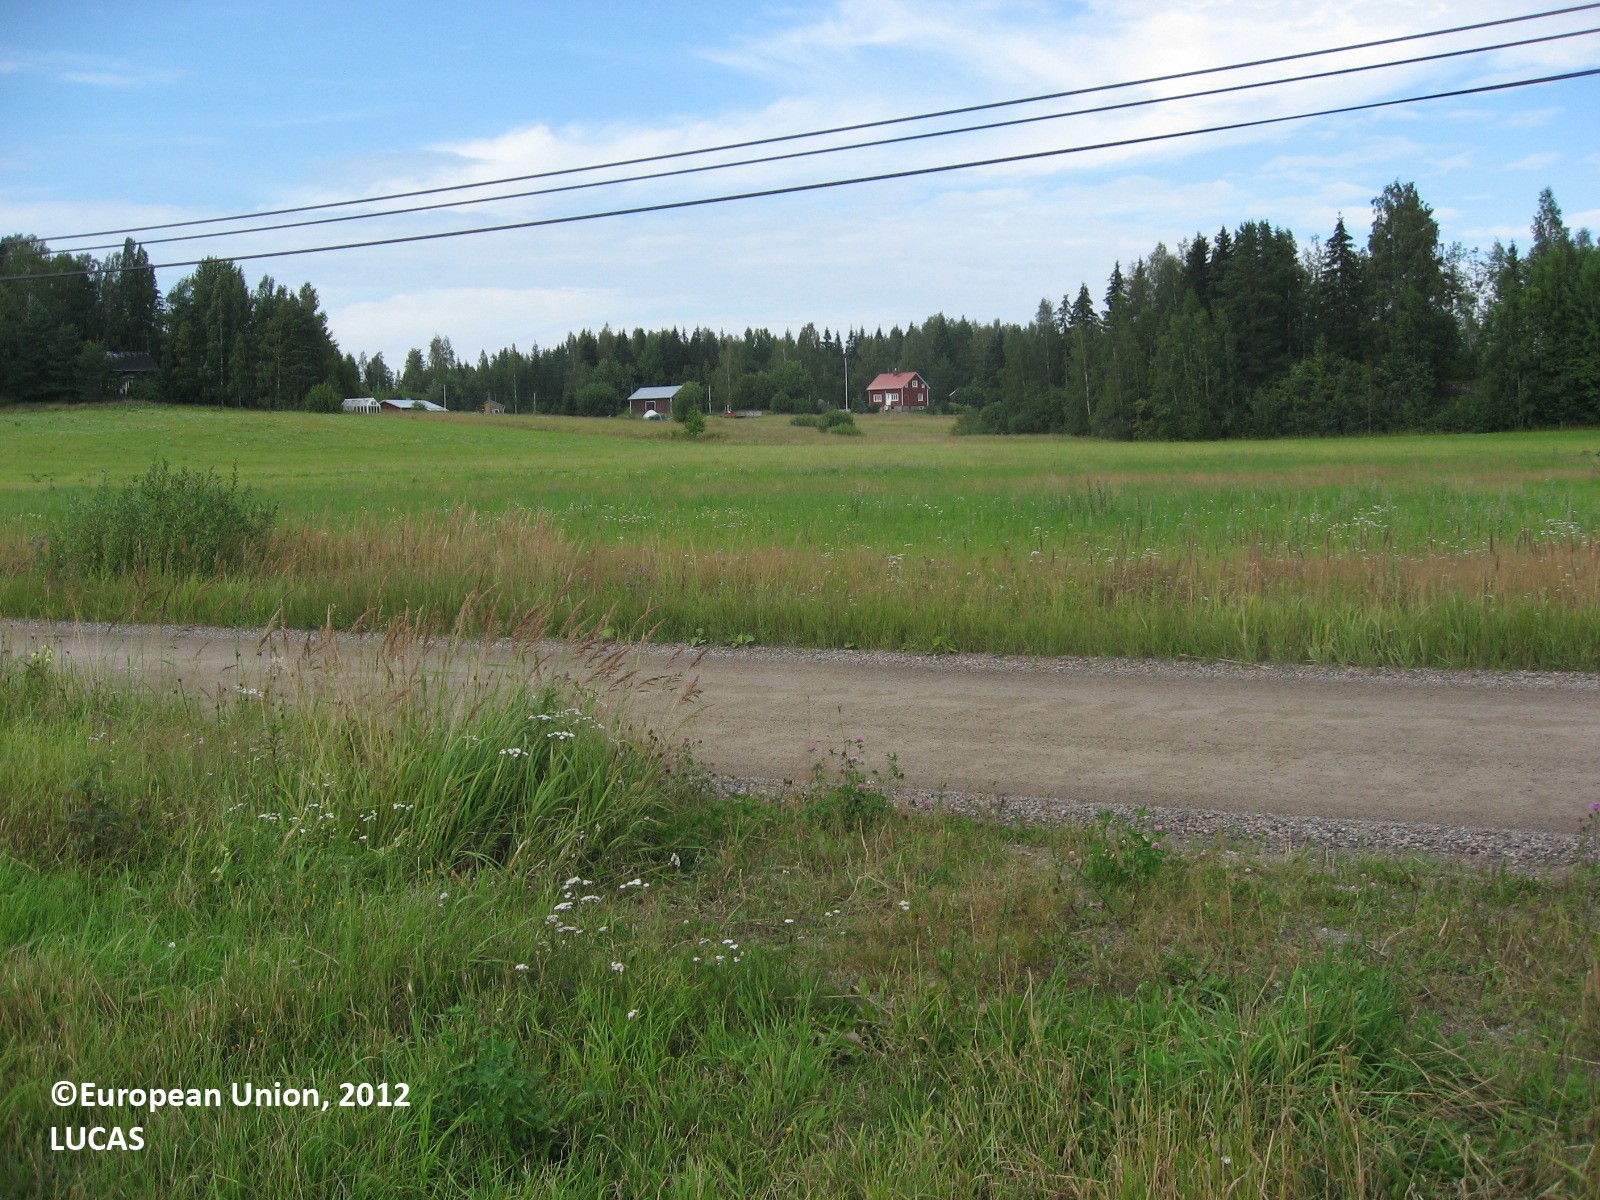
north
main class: Cropland
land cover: Temporary grasslands
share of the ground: > 75 %
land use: Agriculture (excluding fallow land and kitchen gardens)
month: August
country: FI
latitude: 60.3858
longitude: 25.3102
